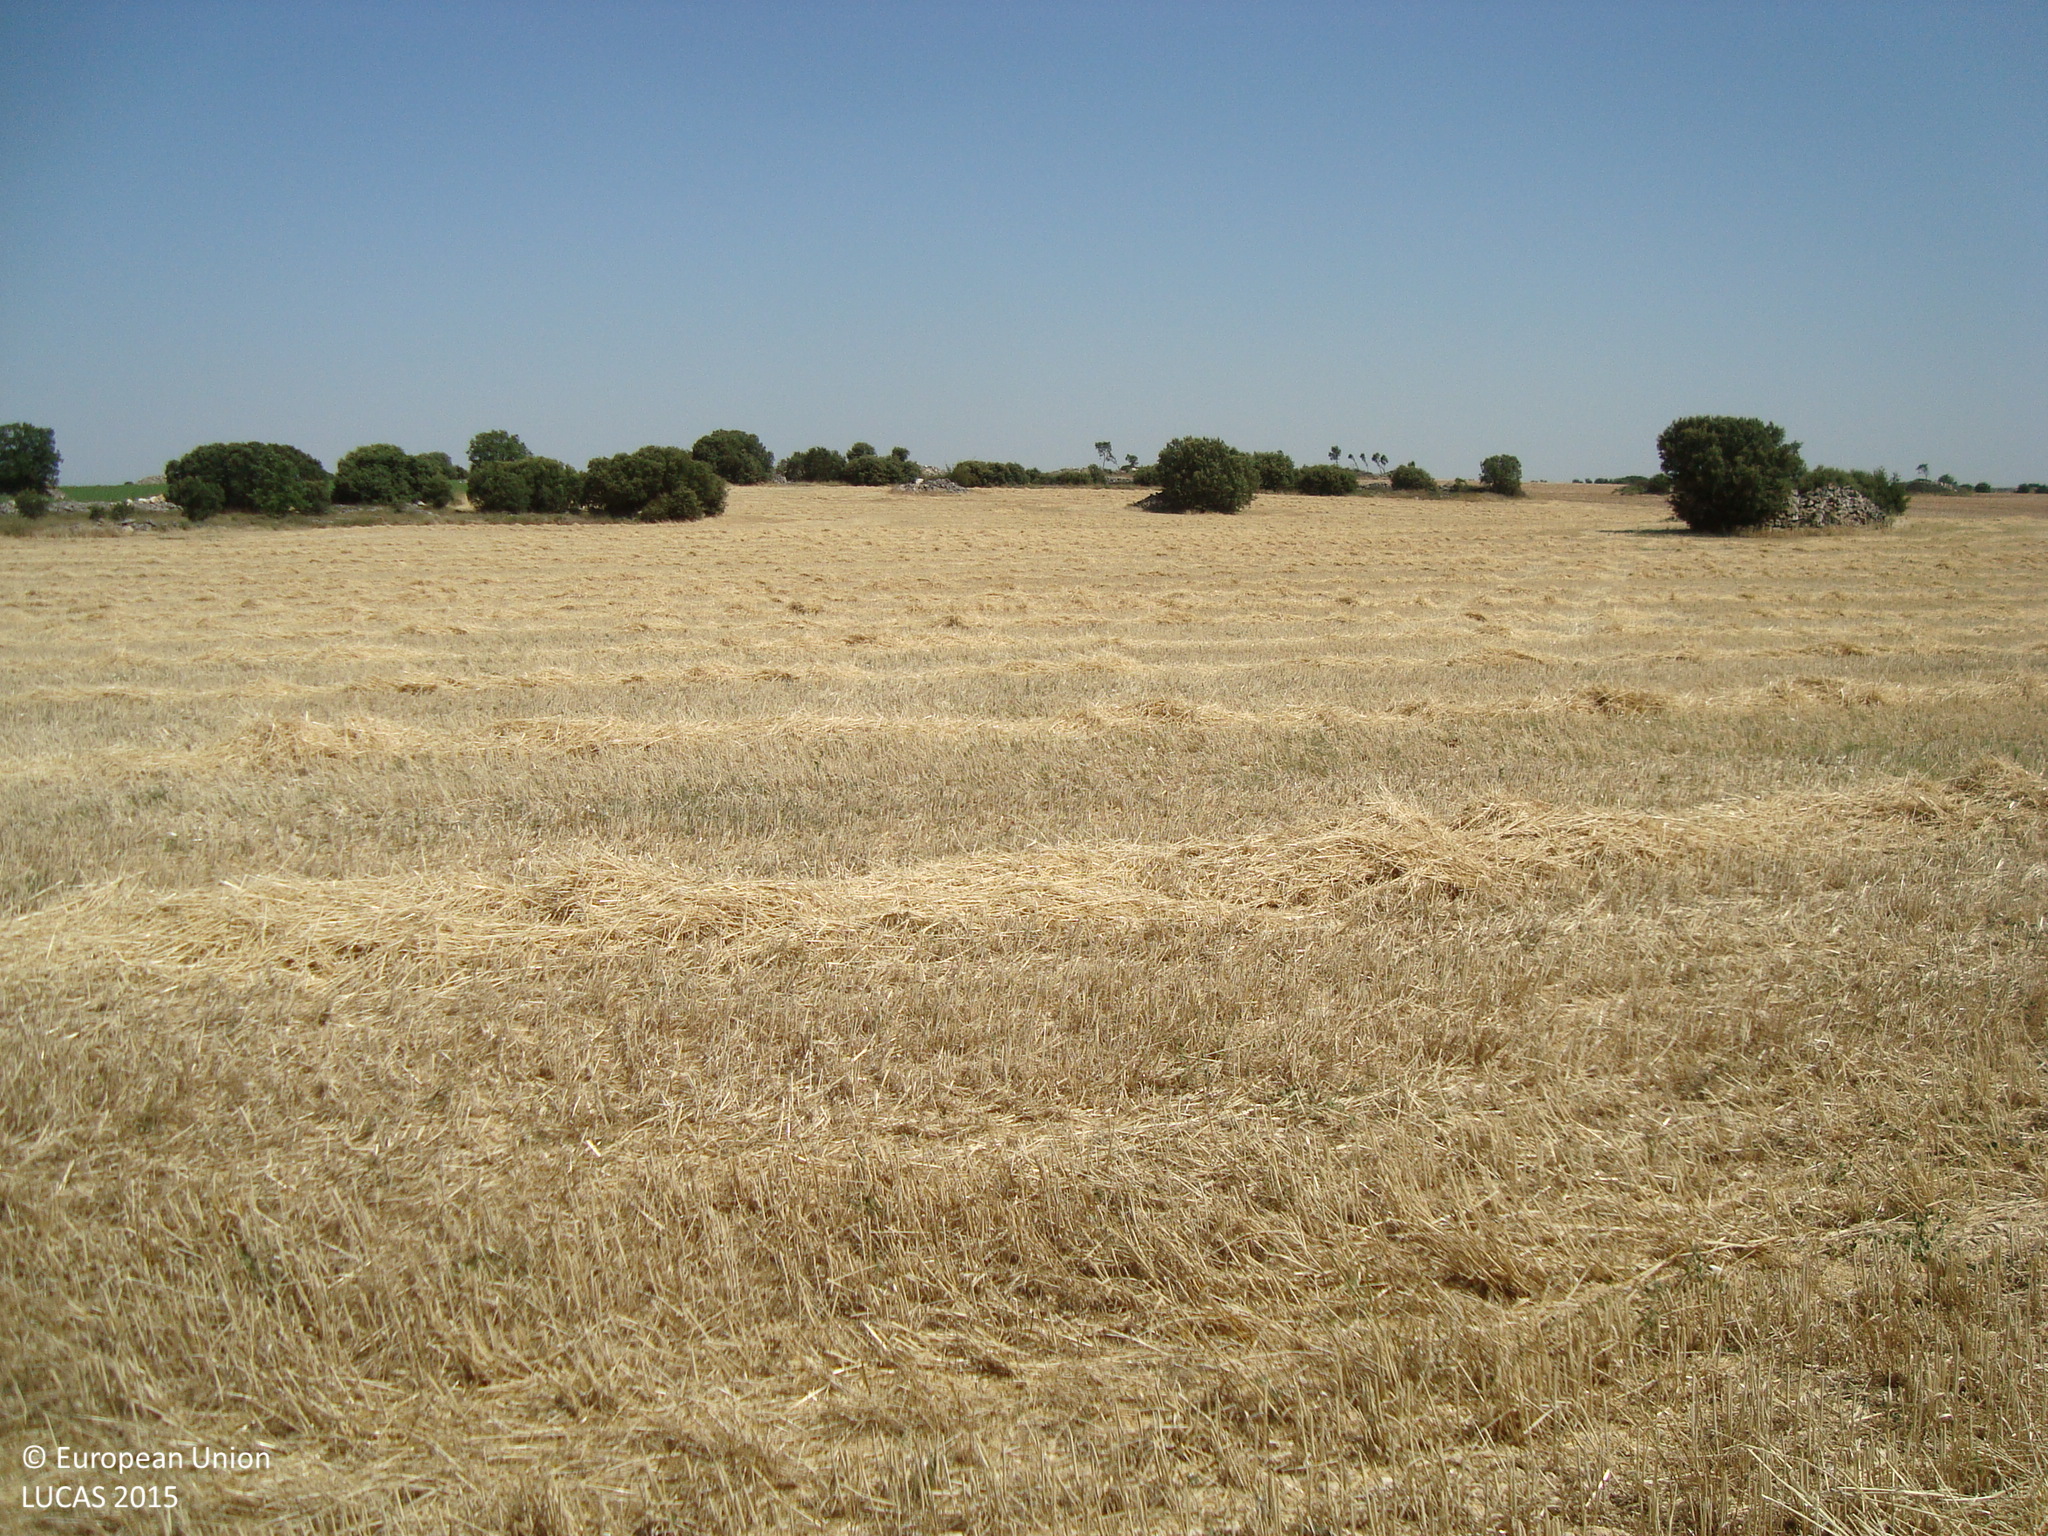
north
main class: Cropland
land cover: Common wheat
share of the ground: > 75 %
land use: Agriculture (excluding fallow land and kitchen gardens)
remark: Harvested field
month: July
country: ES
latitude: 41.8396
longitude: -4.1394
